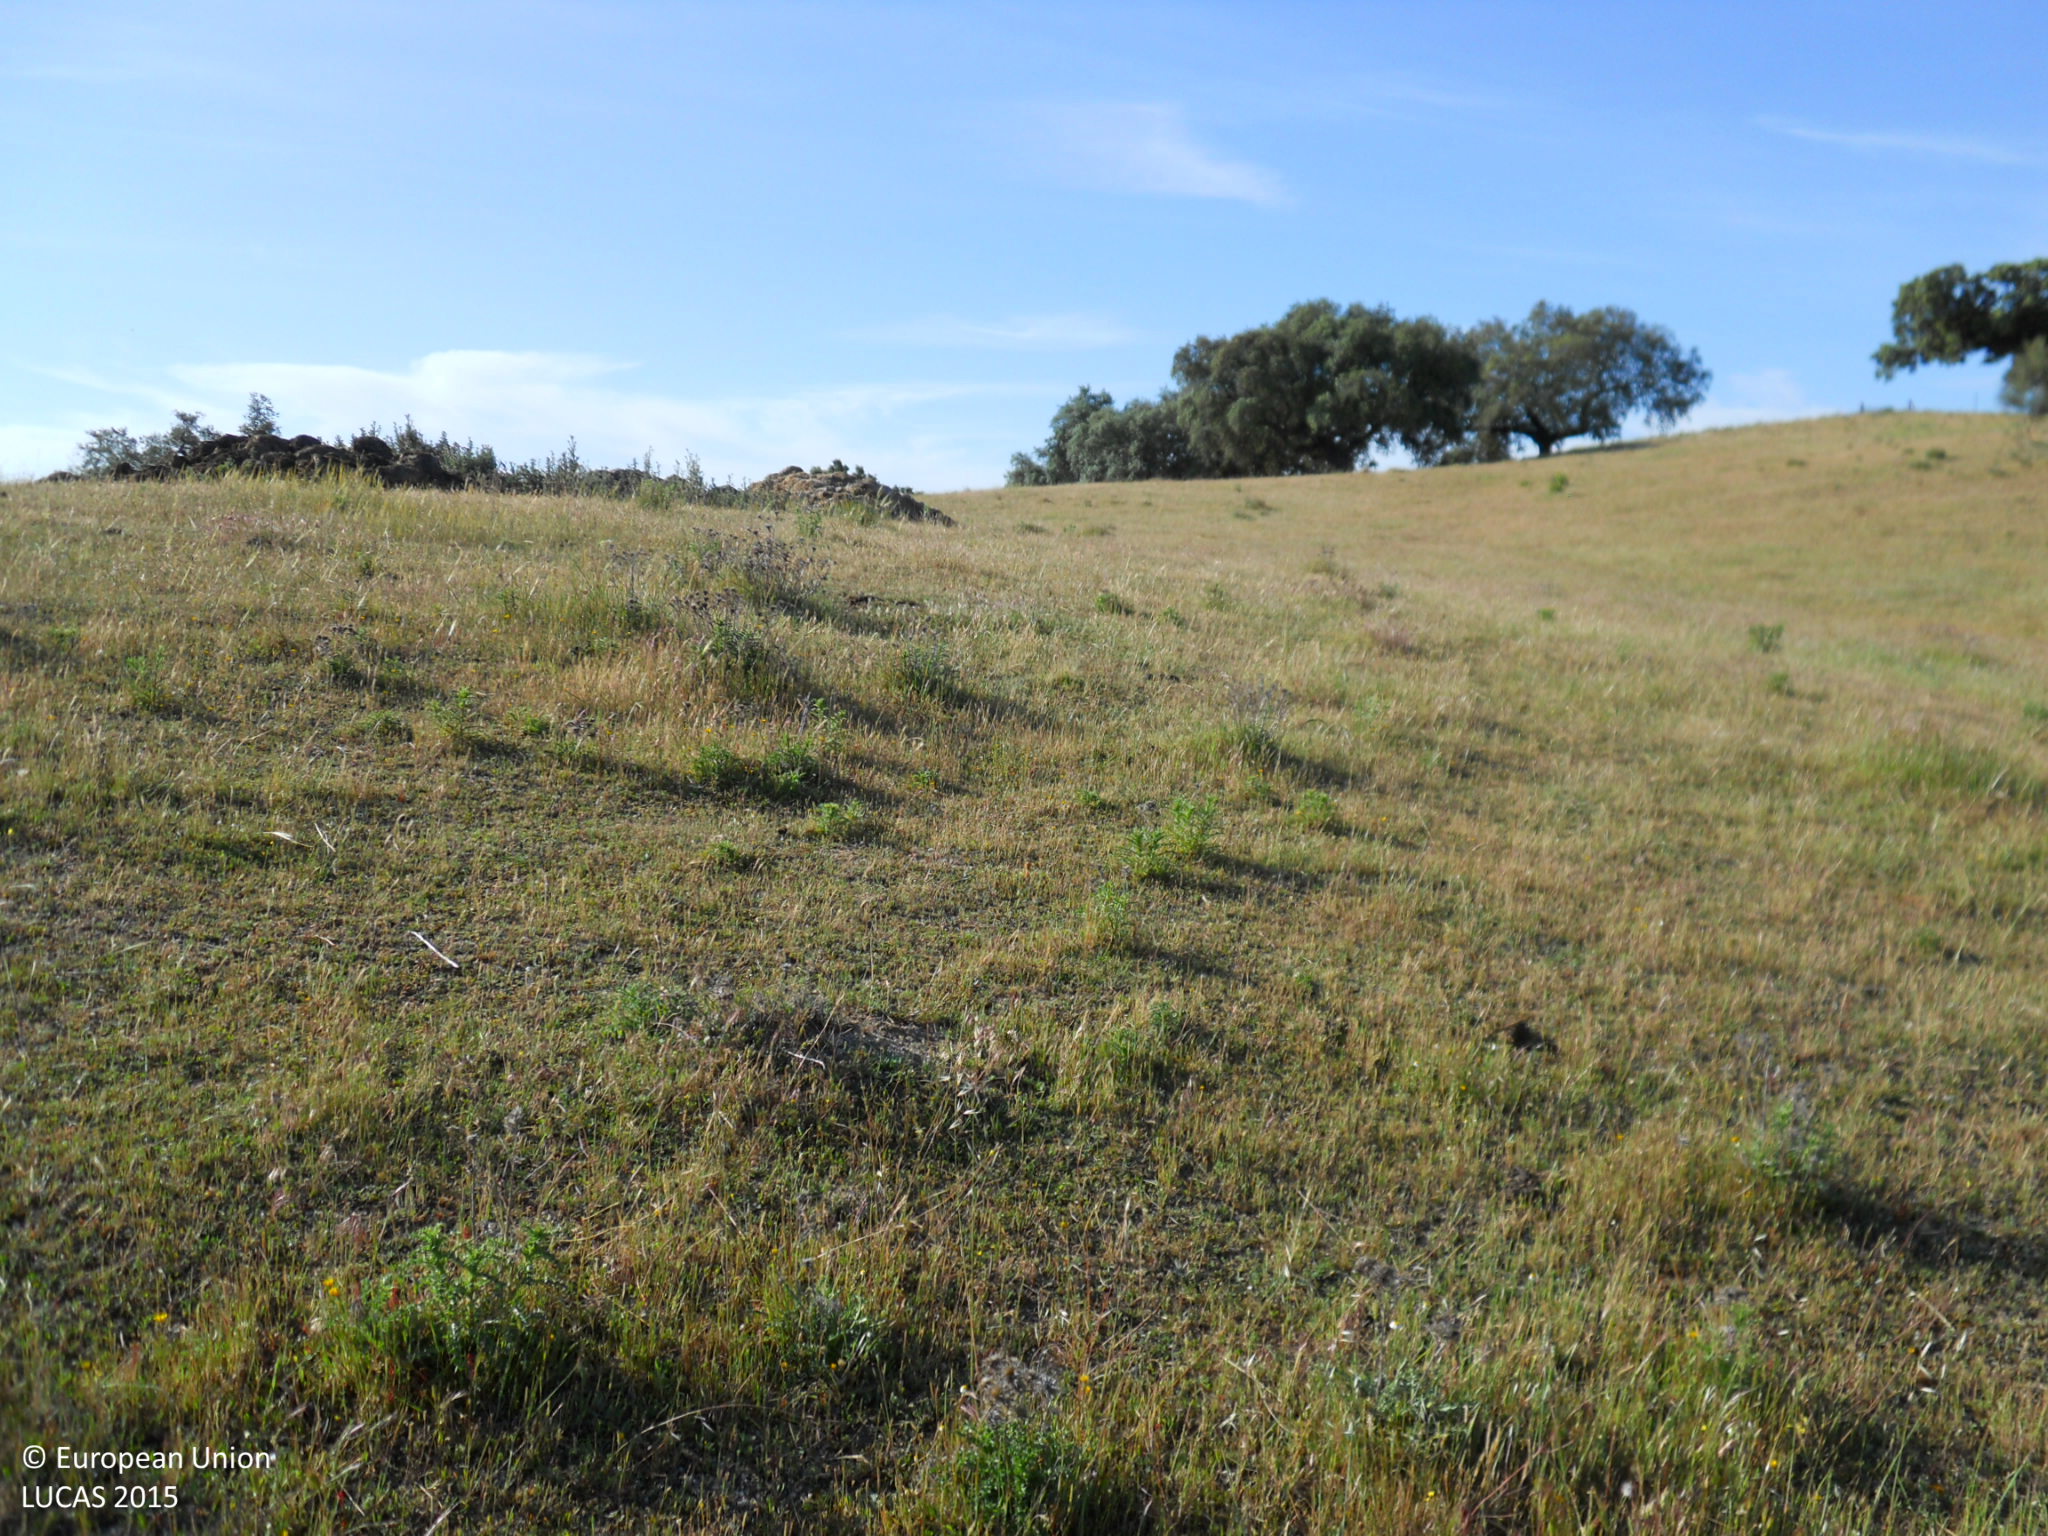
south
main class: Grassland
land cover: Grassland without tree/shrub cover
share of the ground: > 75 %
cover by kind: herbaceous plants 95 %, shrubs 5 %
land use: Agriculture (excluding fallow land and kitchen gardens)
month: April
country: ES
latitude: 39.2265
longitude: -6.9296
